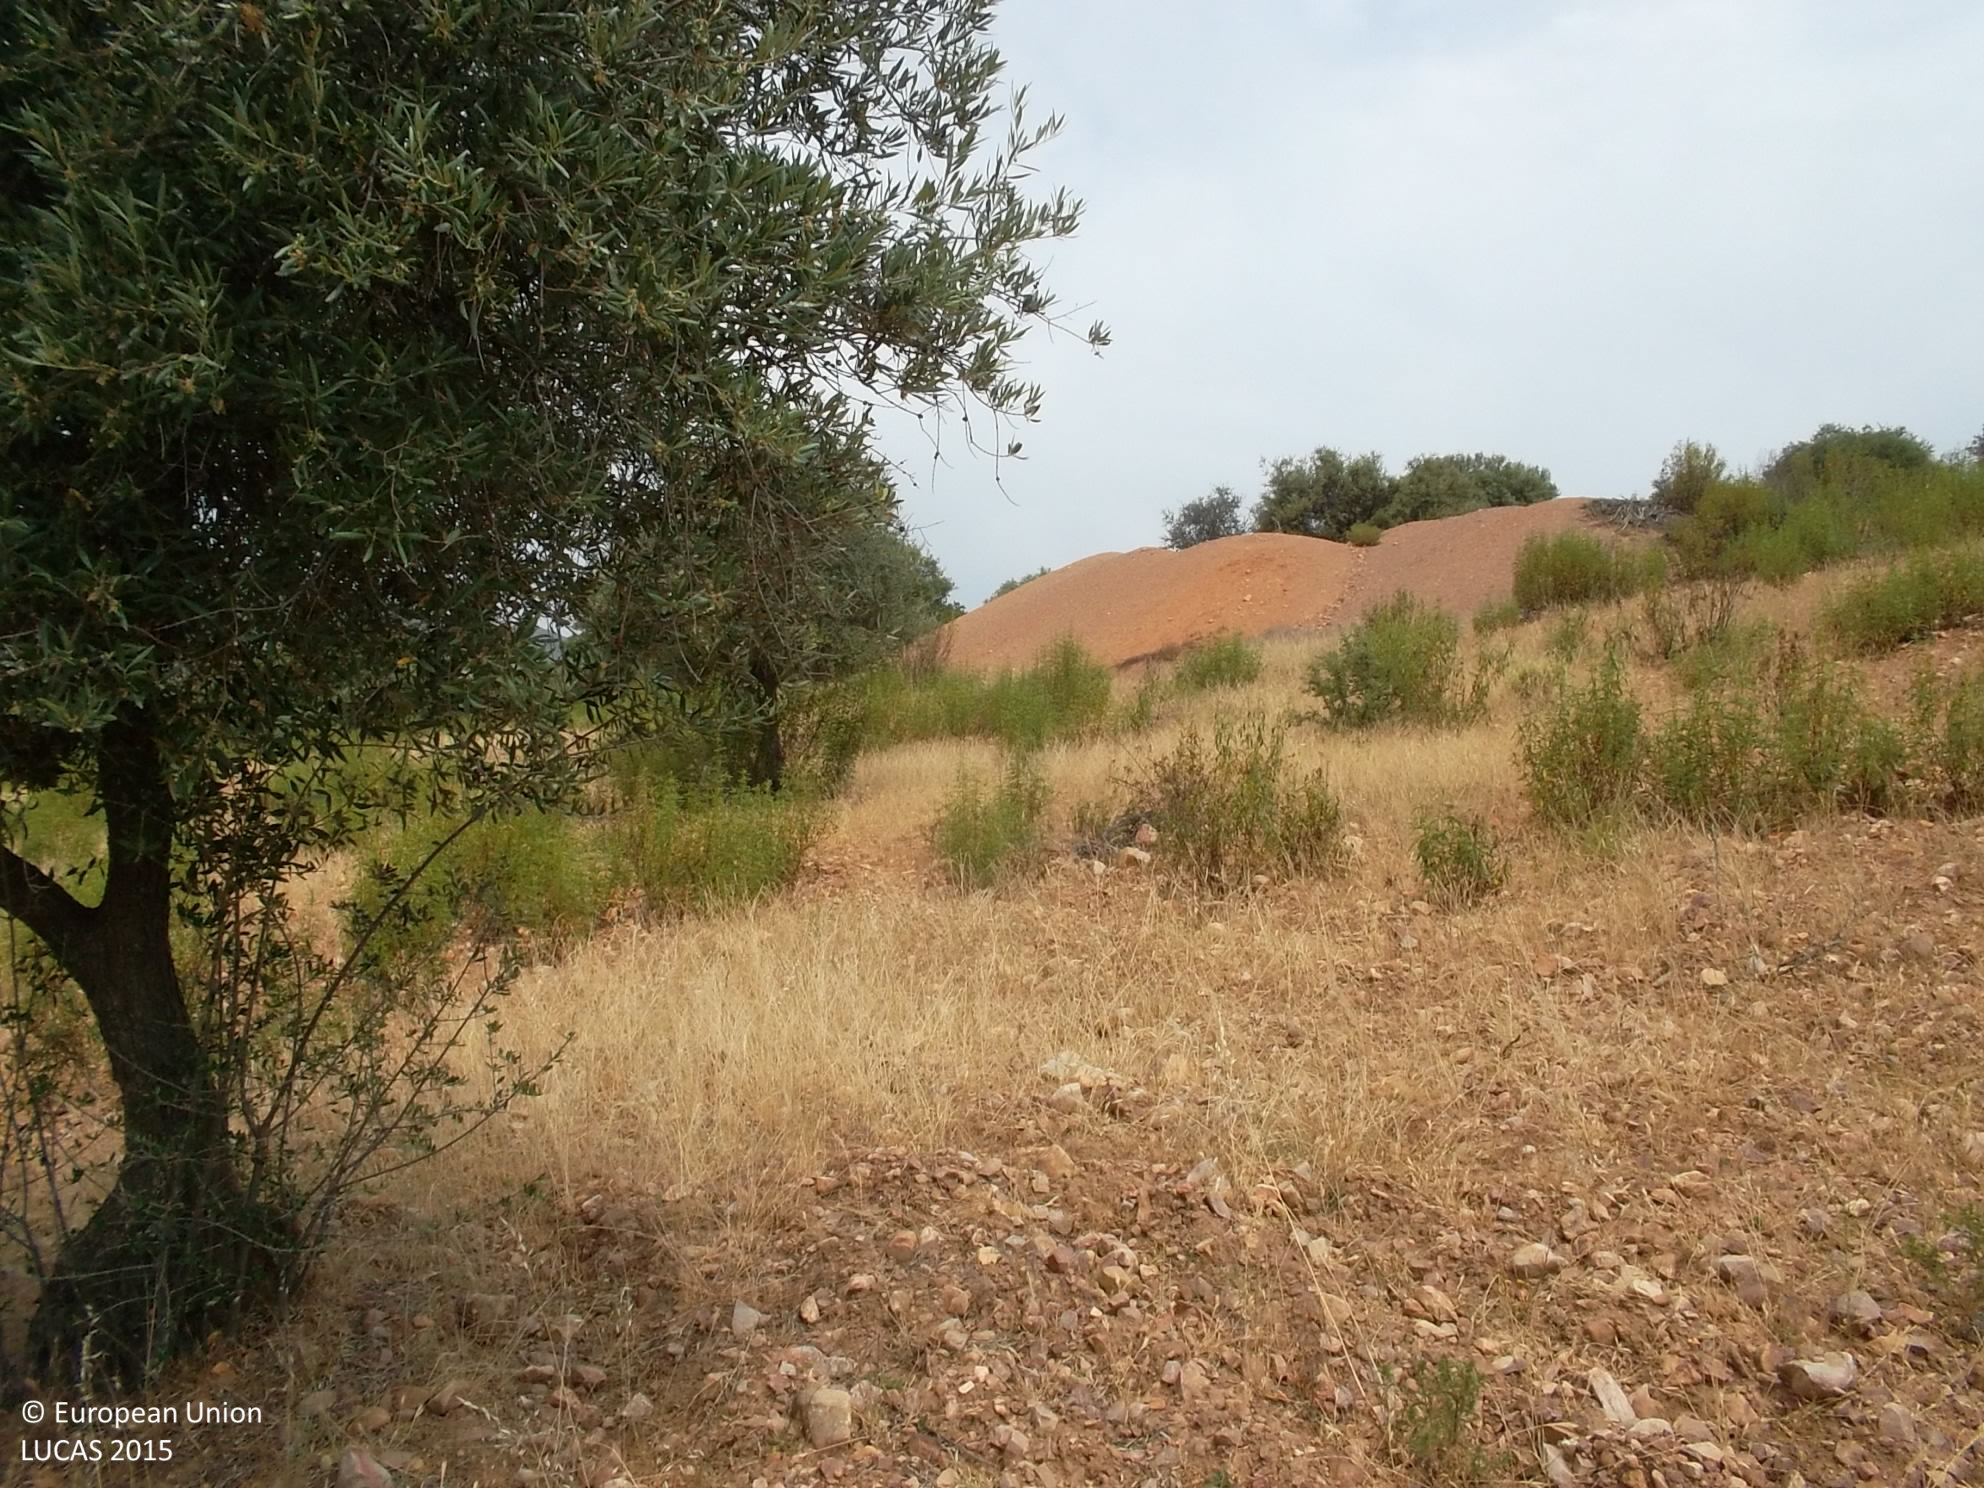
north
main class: Cropland
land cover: Olive groves
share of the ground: 25 - 50 %
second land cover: Spontaneously vegetated surfaces
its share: 10 - 25 %
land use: Agriculture (excluding fallow land and kitchen gardens)
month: June
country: ES
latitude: 39.1261
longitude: -4.8765
